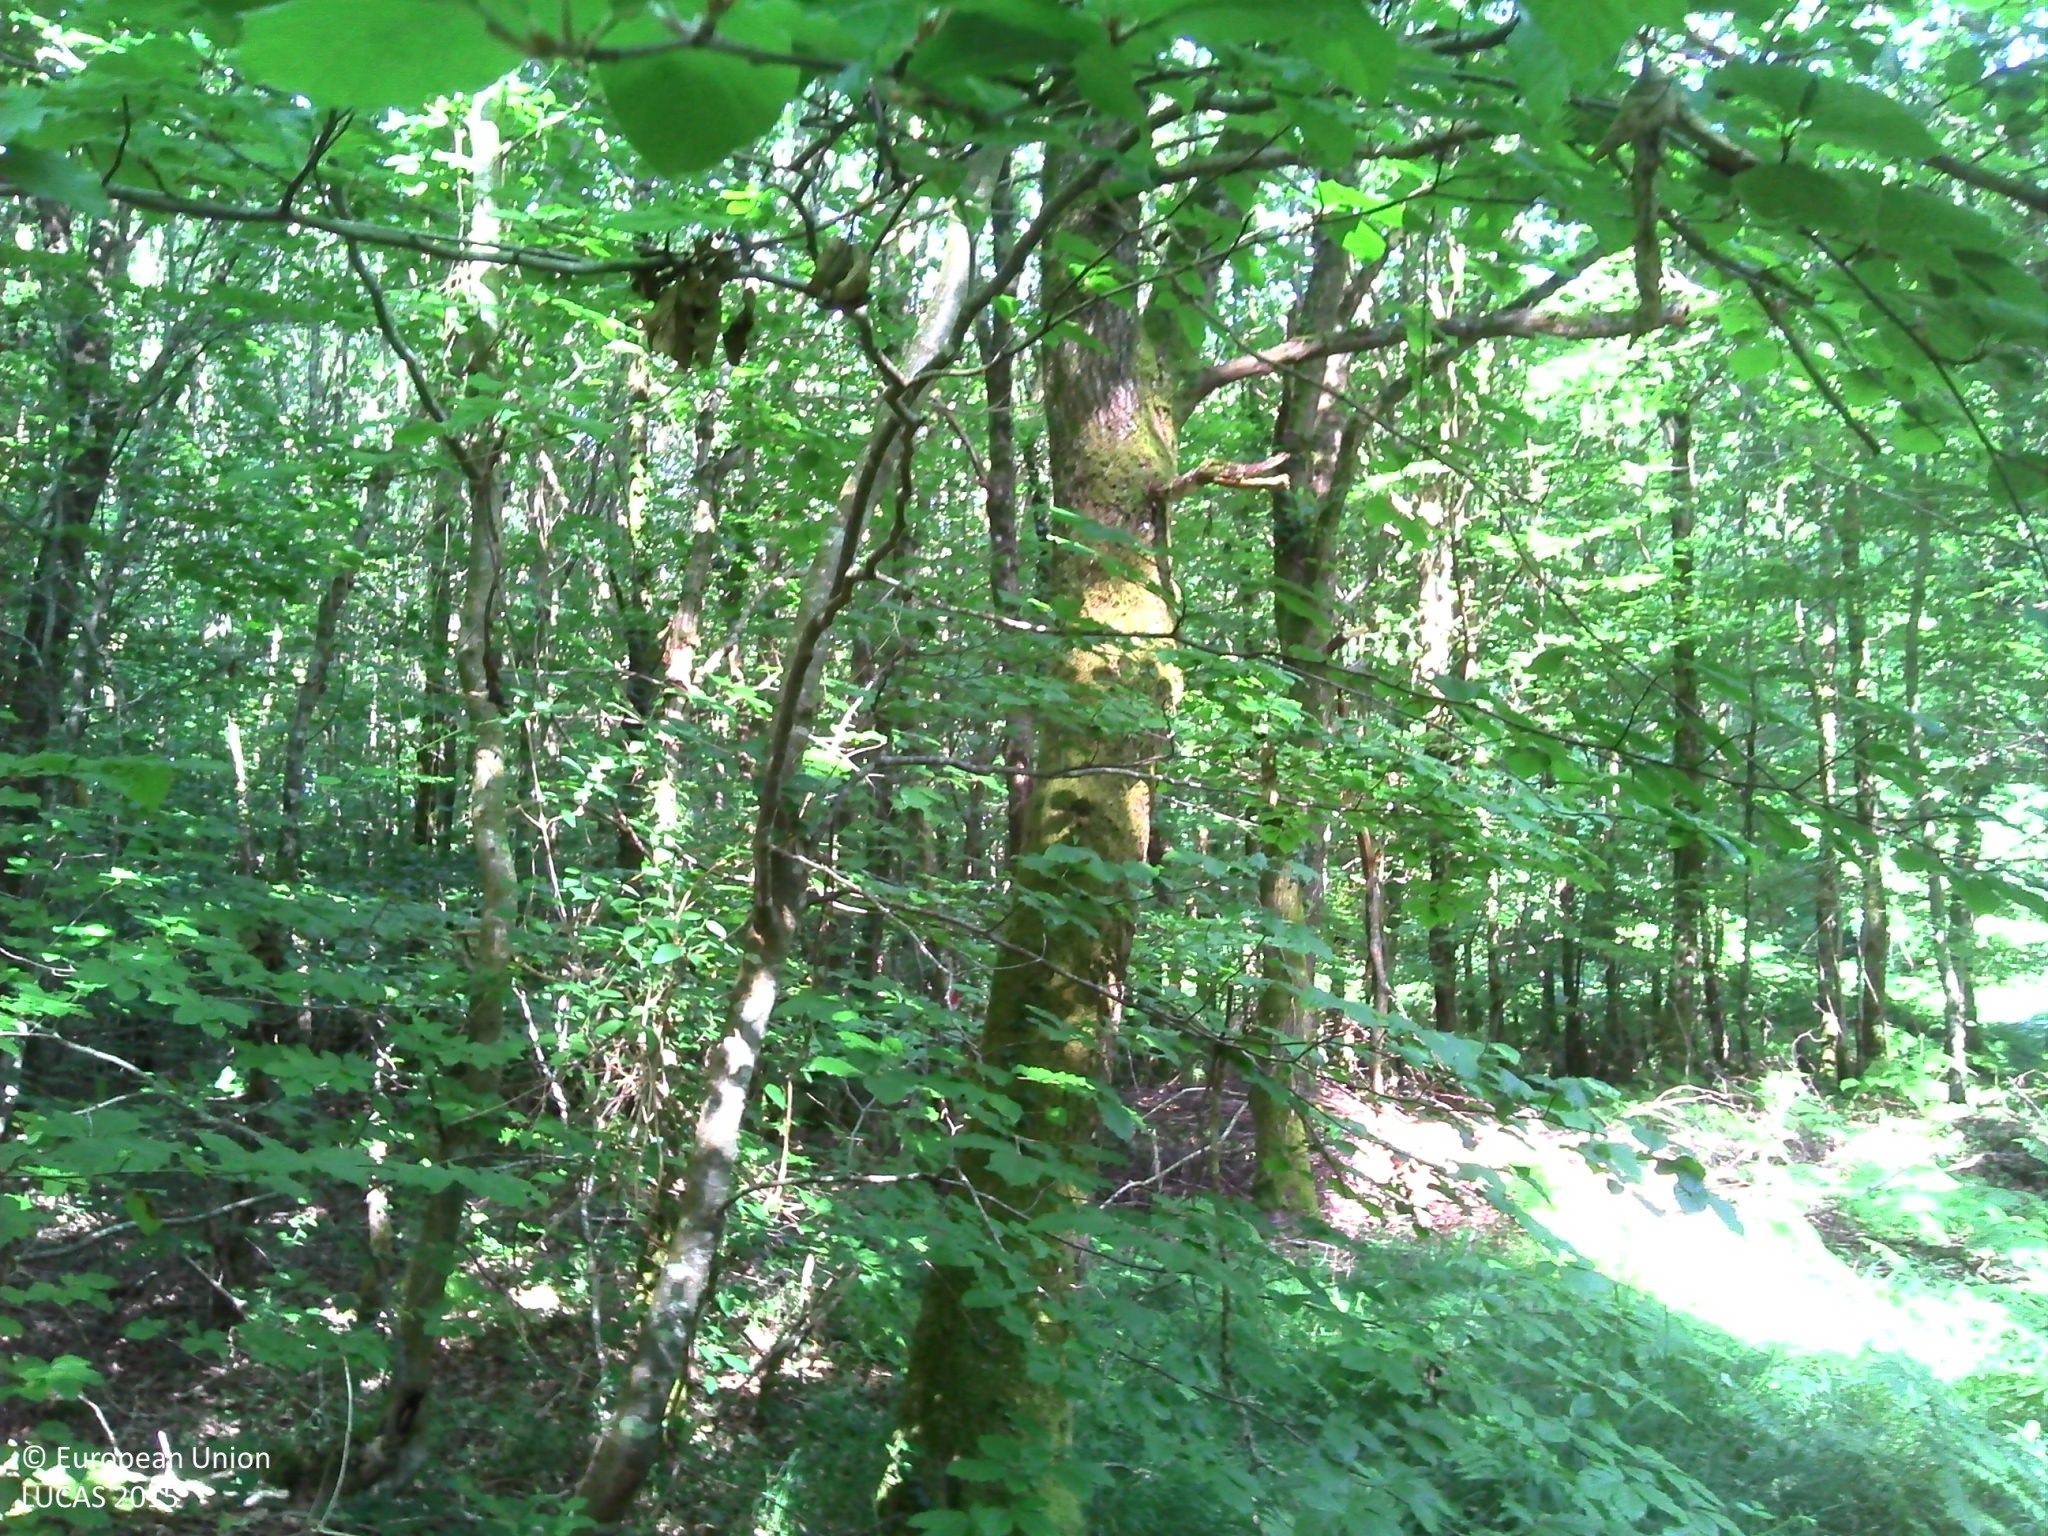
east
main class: Woodland
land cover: Broadleaved woodland
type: beech forest
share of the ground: > 75 %
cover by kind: broadleaved forest trees 75 %, herbaceous plants 15 %, shrubs 10 %
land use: Forestry
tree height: > 5 m
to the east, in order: Broadleaved woodland; Ditches and canals; Grass margins; Tracks; Ditches and canals; Grass margins; Broadleaved woodland; Ditches and canals; Shruby margins; Tracks; Ditches and canals; Grass margins; Shruby margins; Broadleaved woodland
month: June
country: FR
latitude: 48.4051
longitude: 0.2333
